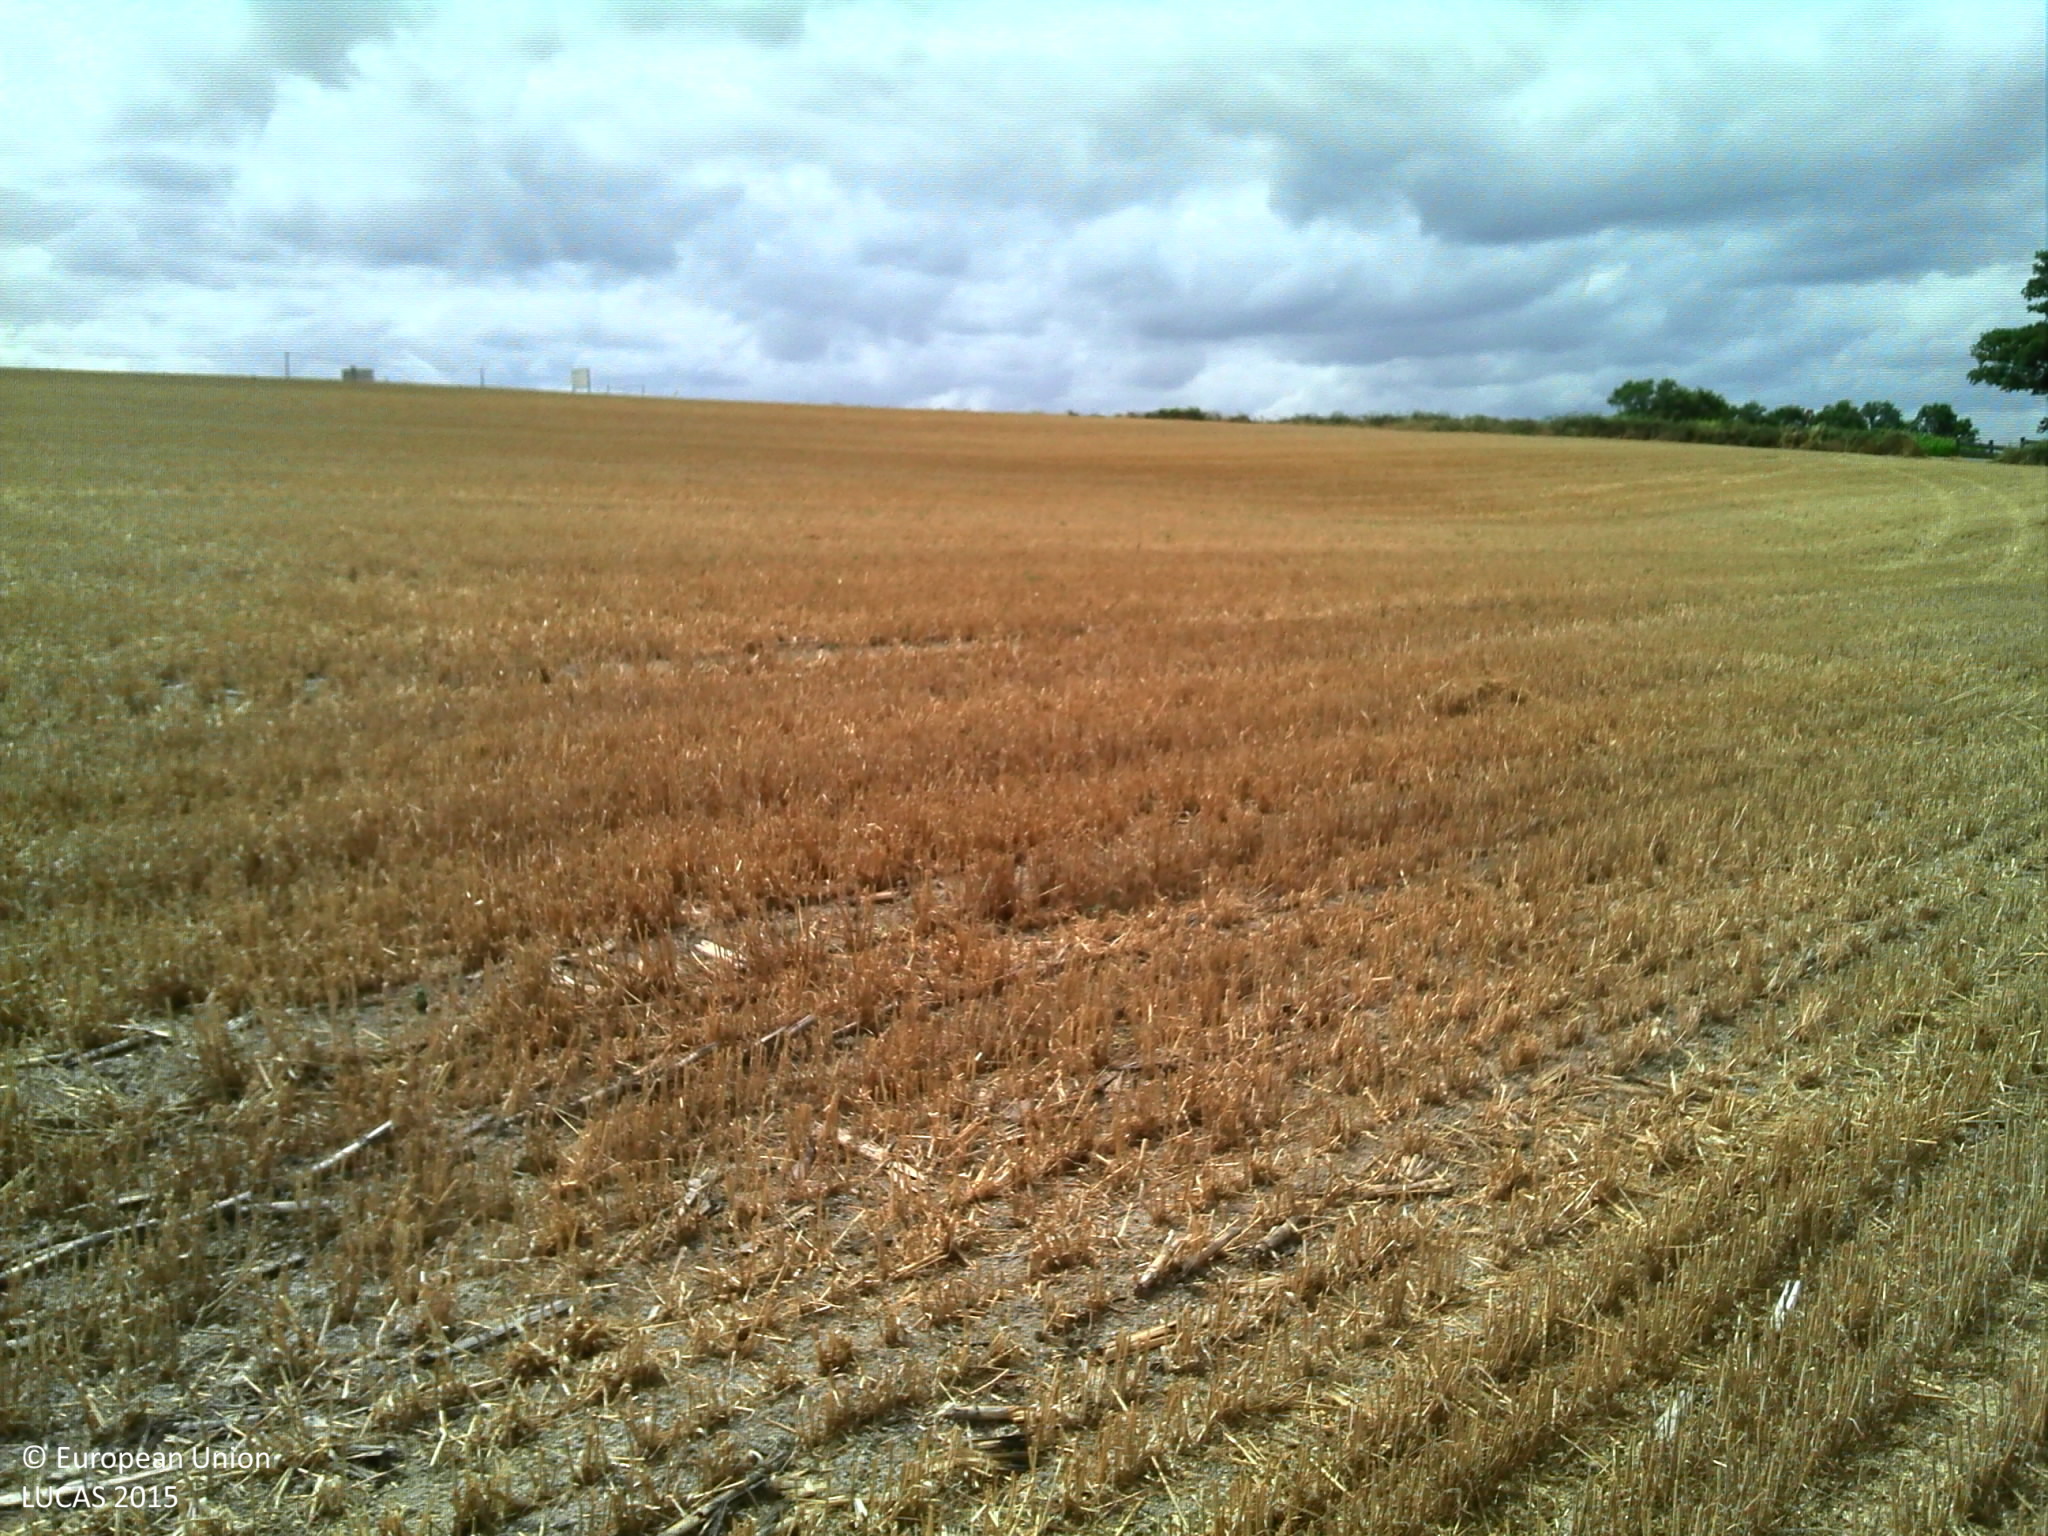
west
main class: Cropland
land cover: Durum wheat
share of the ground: 25 - 50 %
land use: Agriculture (excluding fallow land and kitchen gardens)
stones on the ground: < 10 %
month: July
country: FR
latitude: 46.9425
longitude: -0.8441
